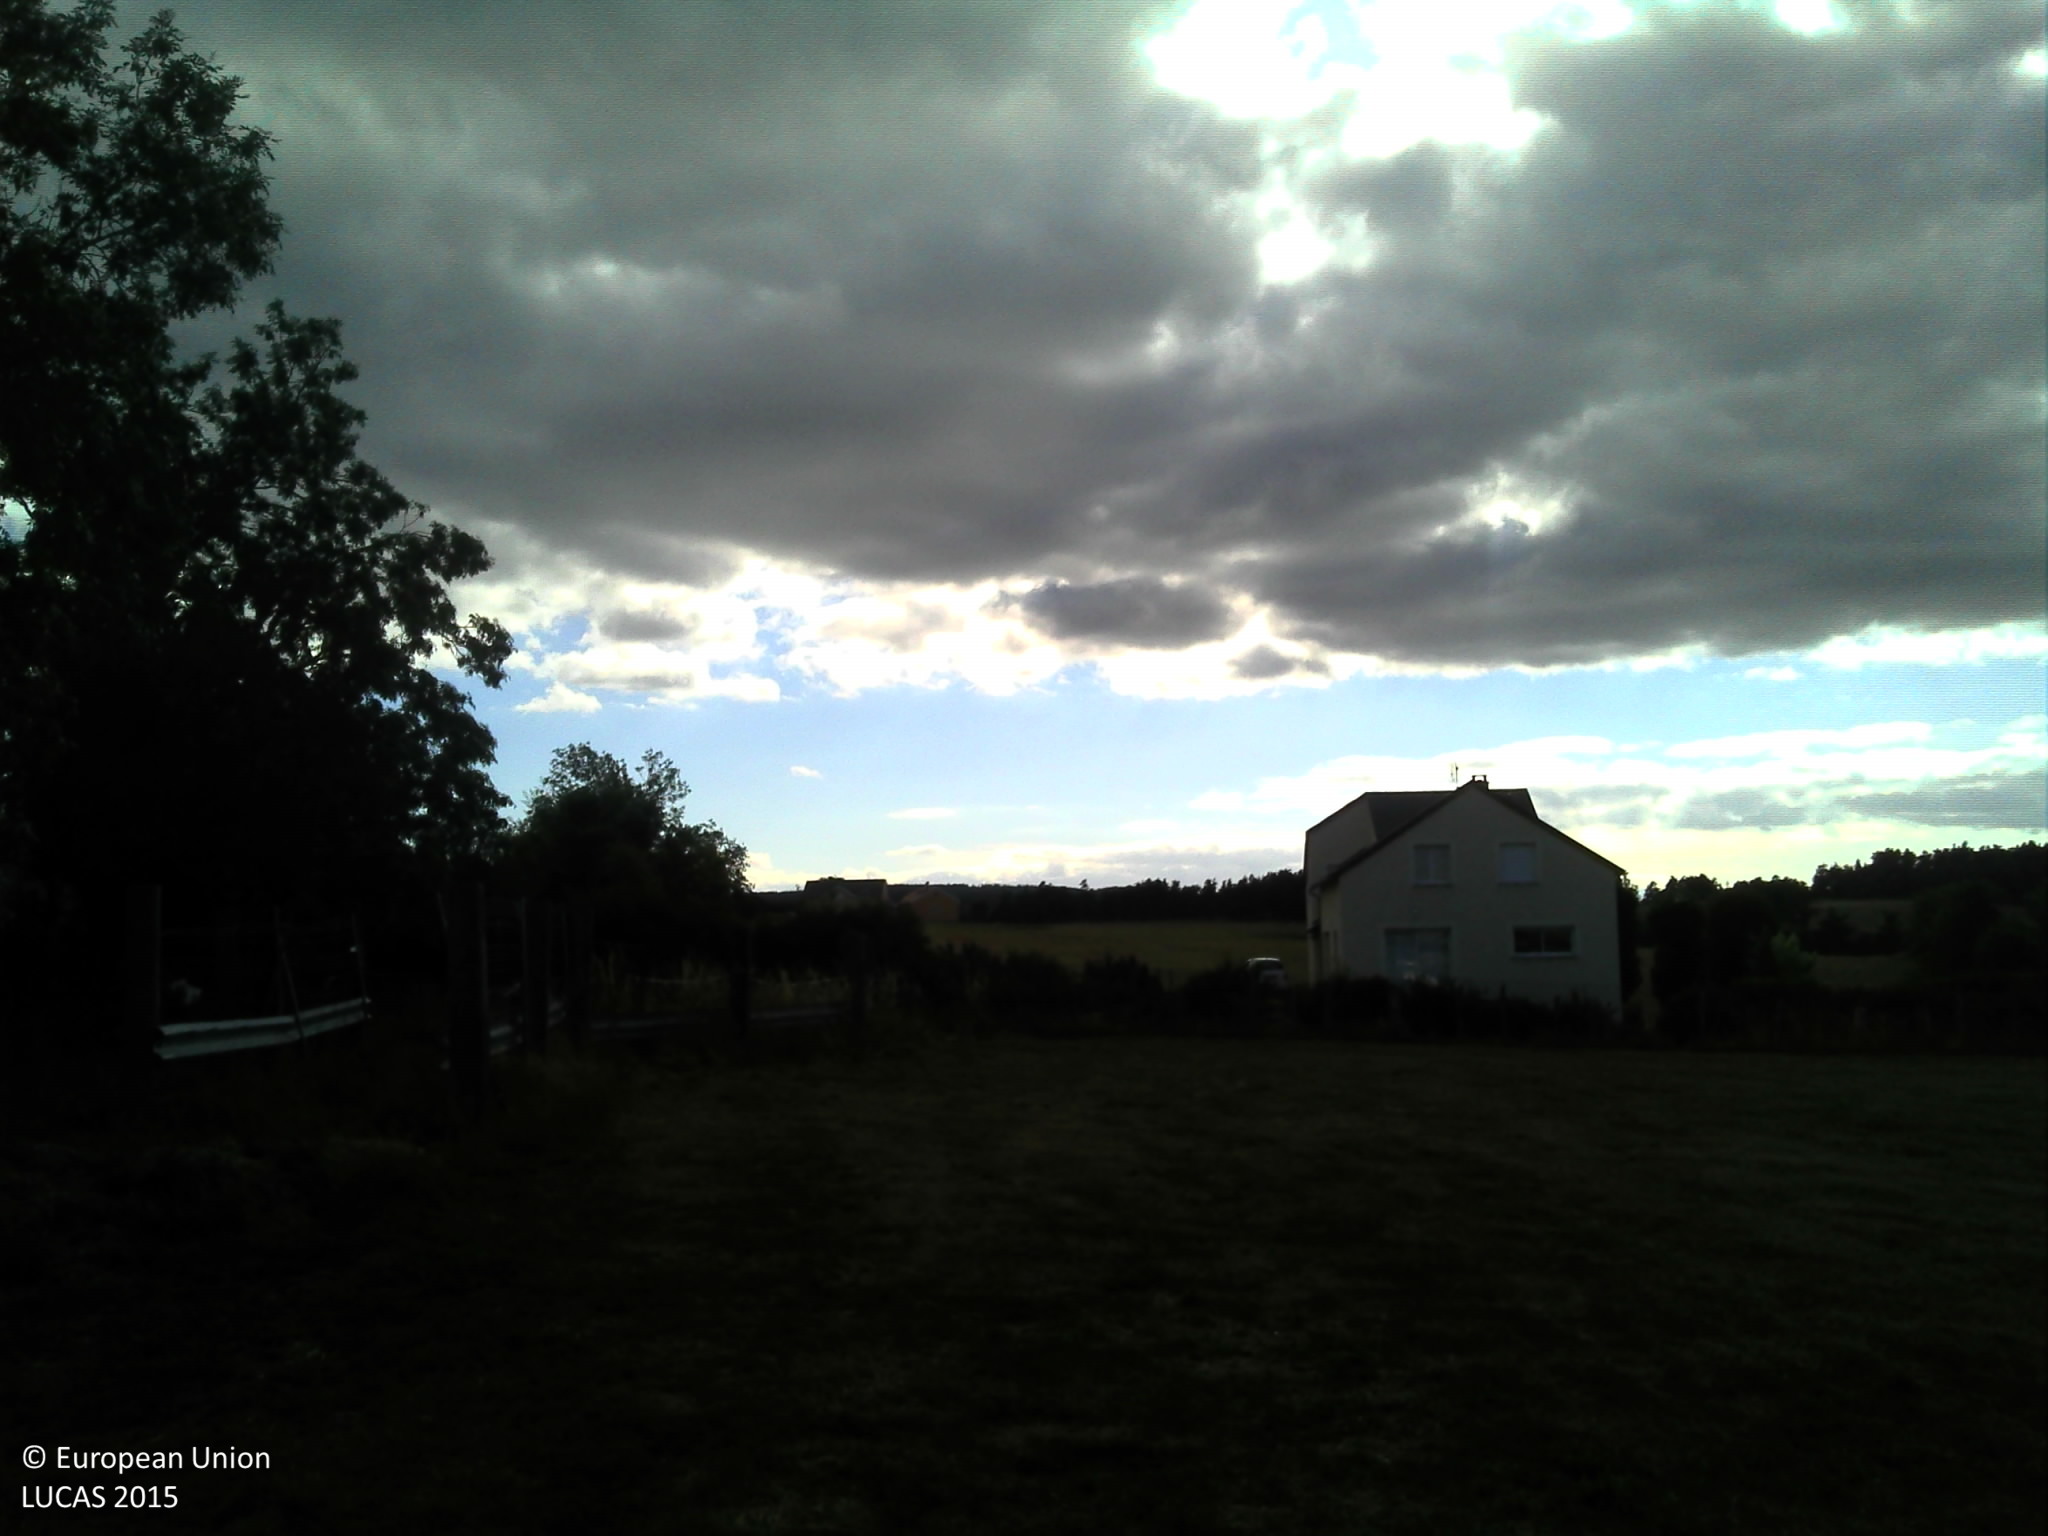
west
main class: Grassland
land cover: Grassland without tree/shrub cover
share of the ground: > 75 %
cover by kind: herbaceous plants 95 %, shrubs 5 %
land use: Agriculture (excluding fallow land and kitchen gardens)
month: July
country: FR
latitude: 44.8010
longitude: 3.2653
